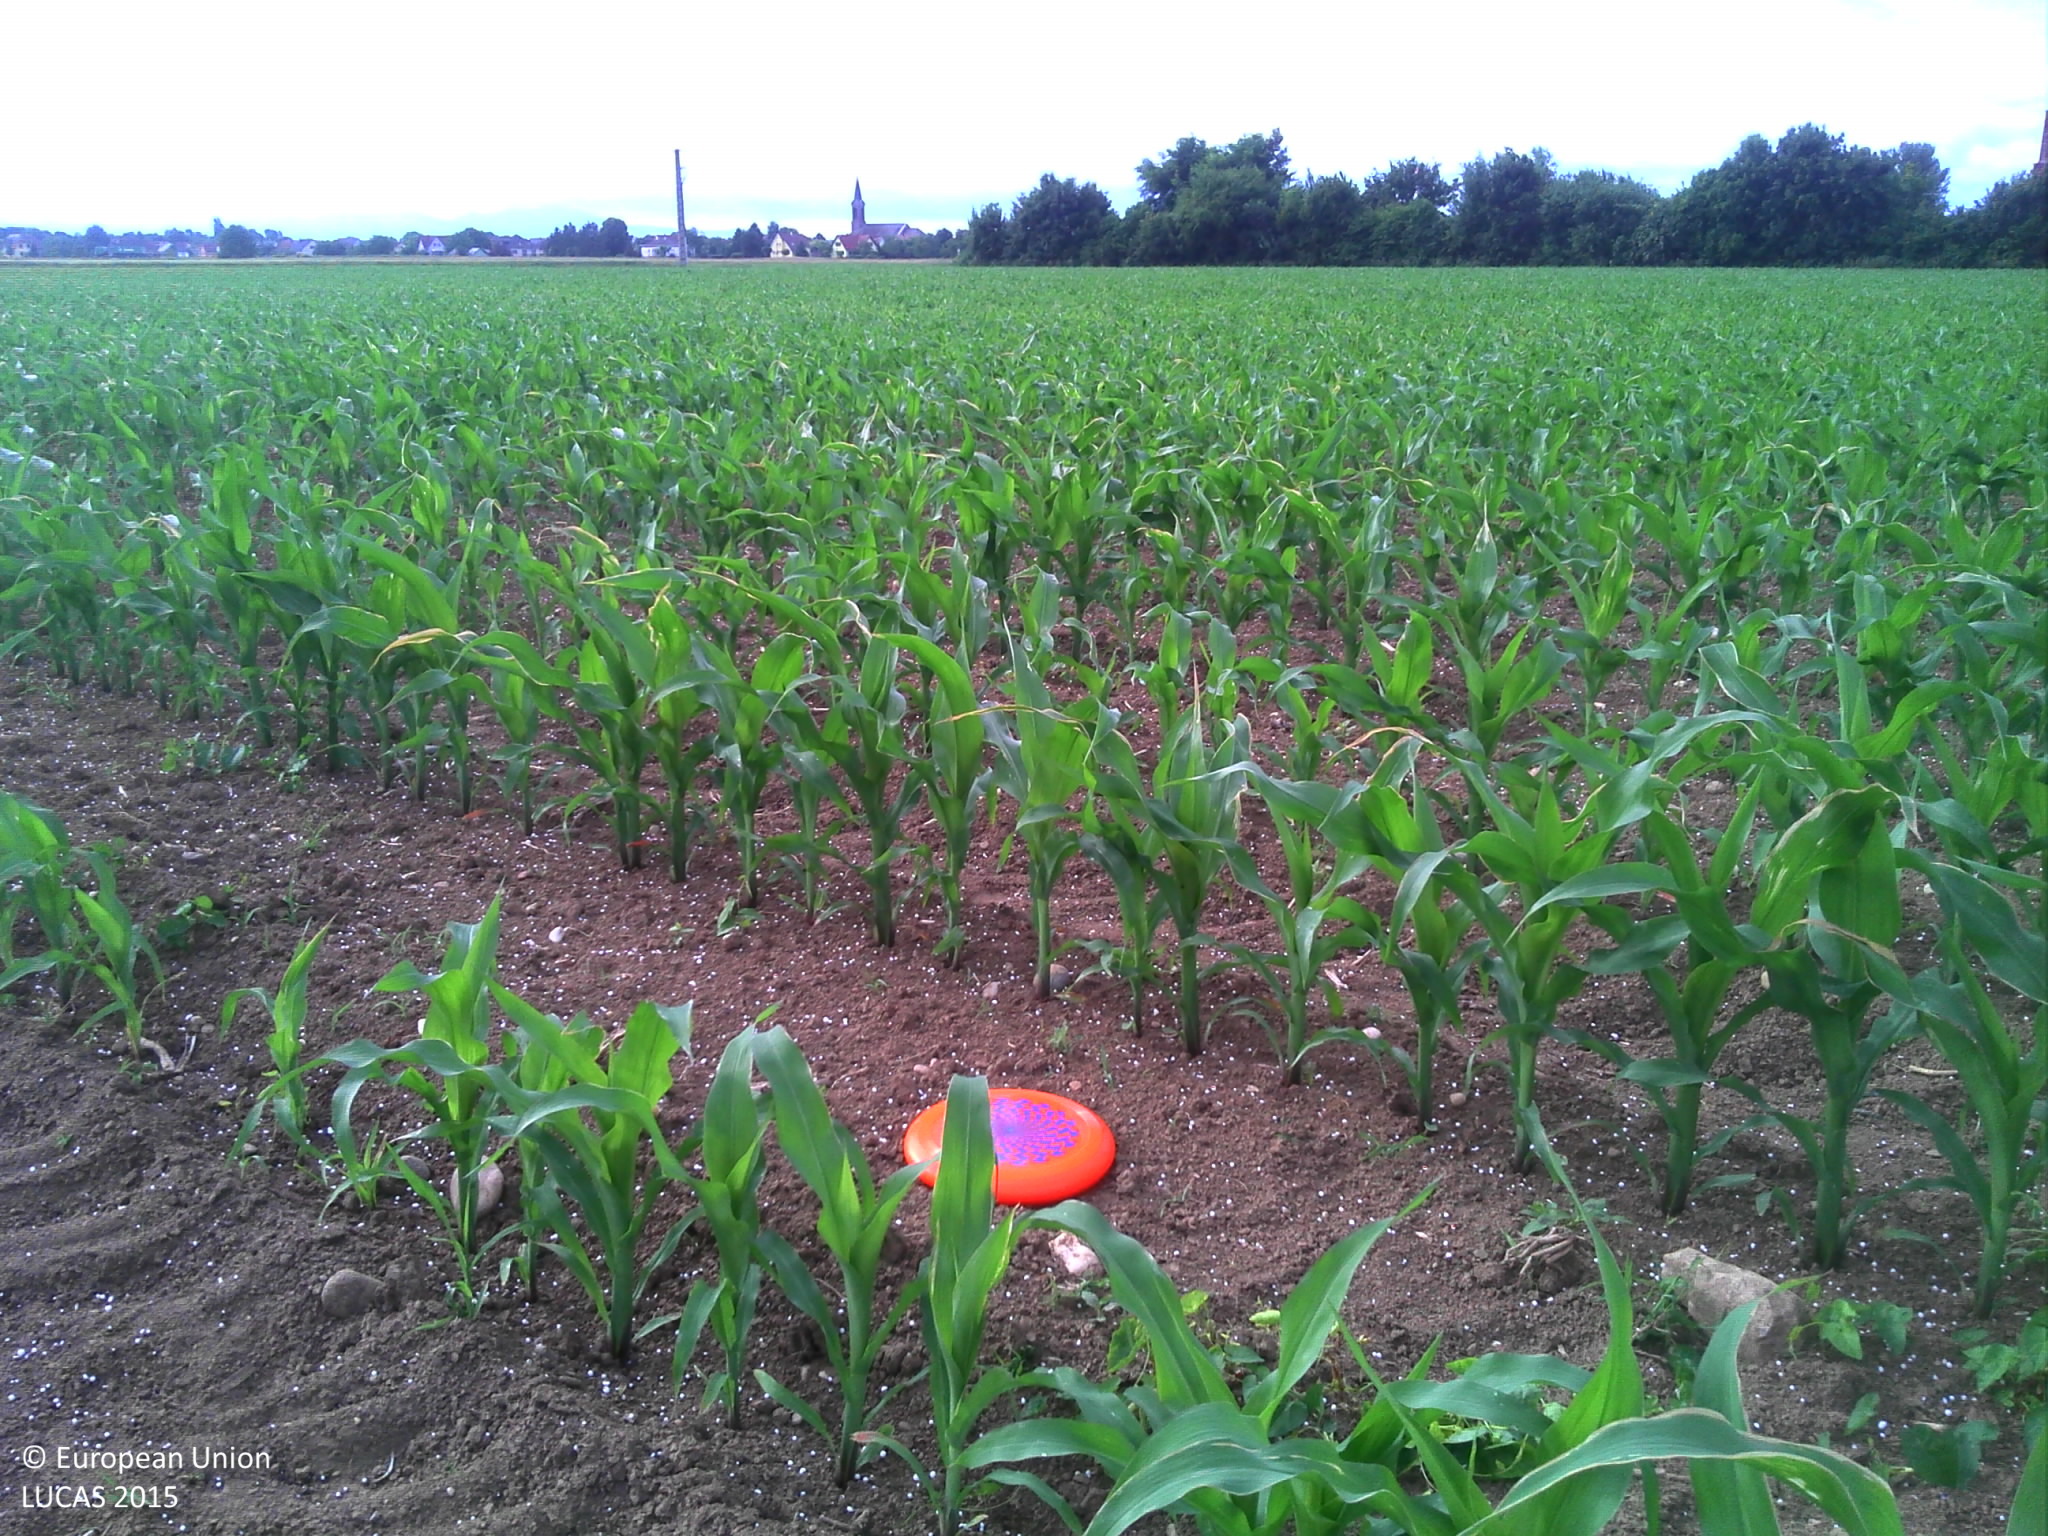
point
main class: Cropland
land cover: Maize
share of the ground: 10 - 25 %
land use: Agriculture (excluding fallow land and kitchen gardens)
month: June
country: FR
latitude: 47.9946
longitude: 7.3880
